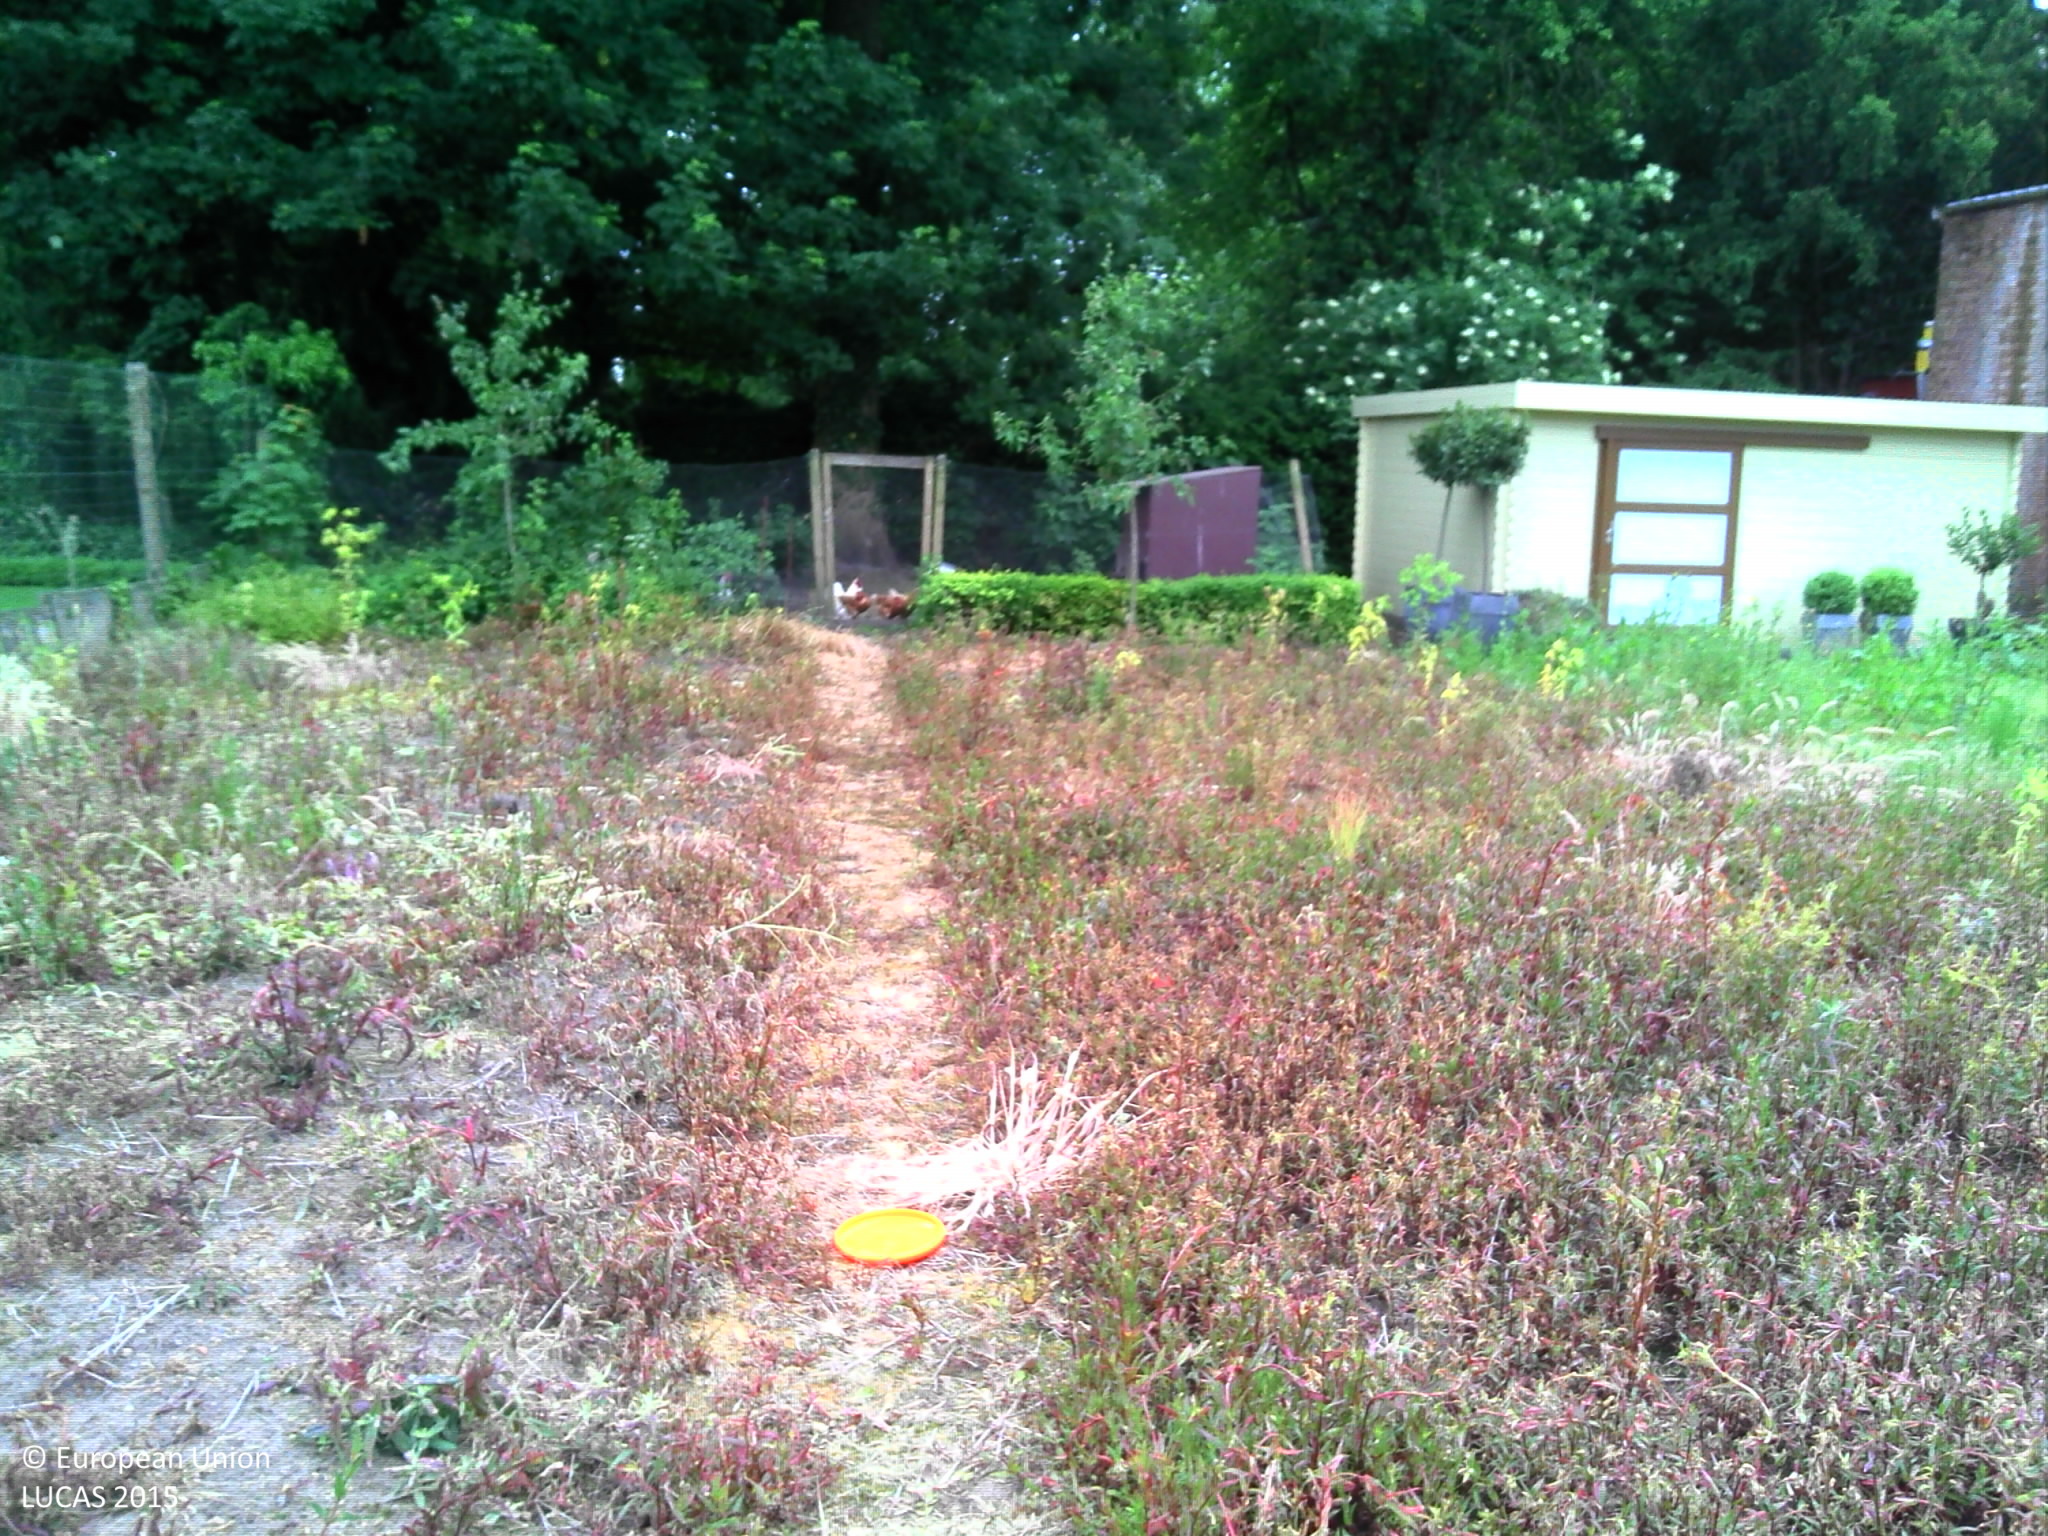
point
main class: Grassland
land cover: Spontaneously vegetated surfaces
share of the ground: > 75 %
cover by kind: herbaceous plants 70 %, lichens and mosses 30 %
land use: Residential
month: June
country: BE
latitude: 50.9847
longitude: 4.0542
